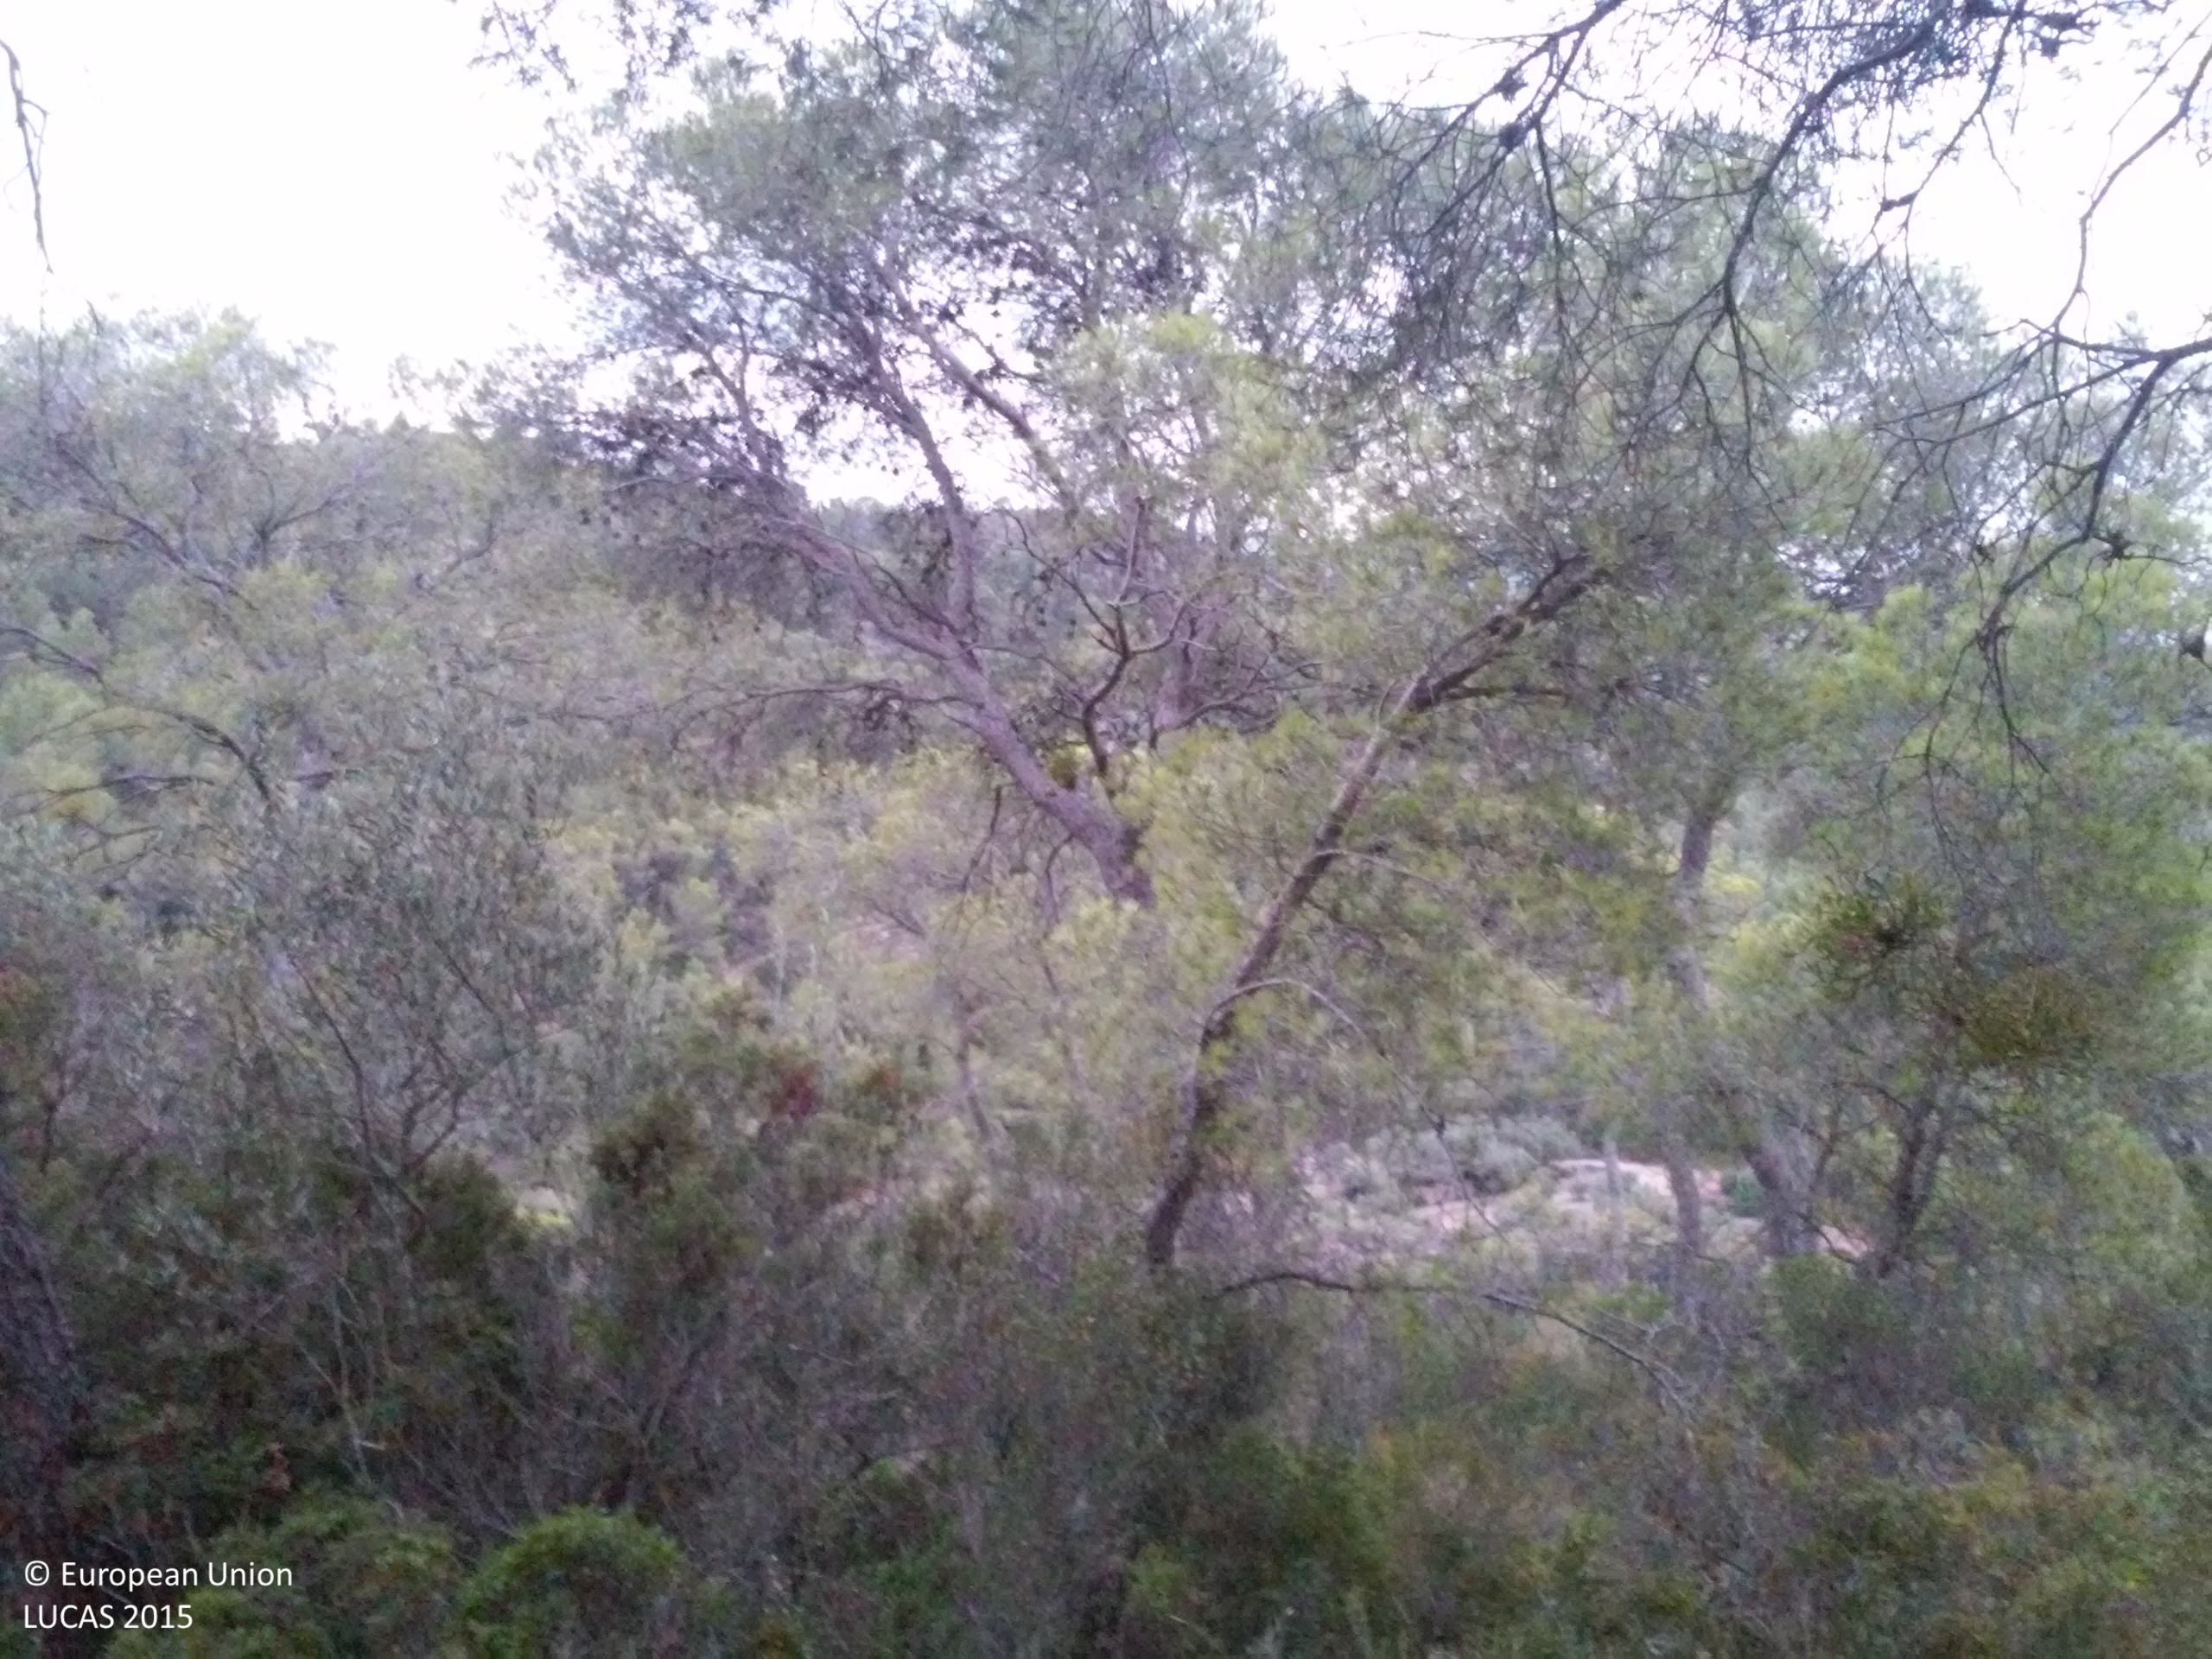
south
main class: Woodland
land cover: Pine dominated coniferous woodland
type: coniferous forest of the mediterranean region
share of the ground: 10 - 25 %
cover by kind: shrubs 50 %, herbaceous plants 30 %, coniferous forest trees 20 %
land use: Semi-natural and natural areas not in use
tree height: > 5 m
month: August
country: ES
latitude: 41.0104
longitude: 0.5394
